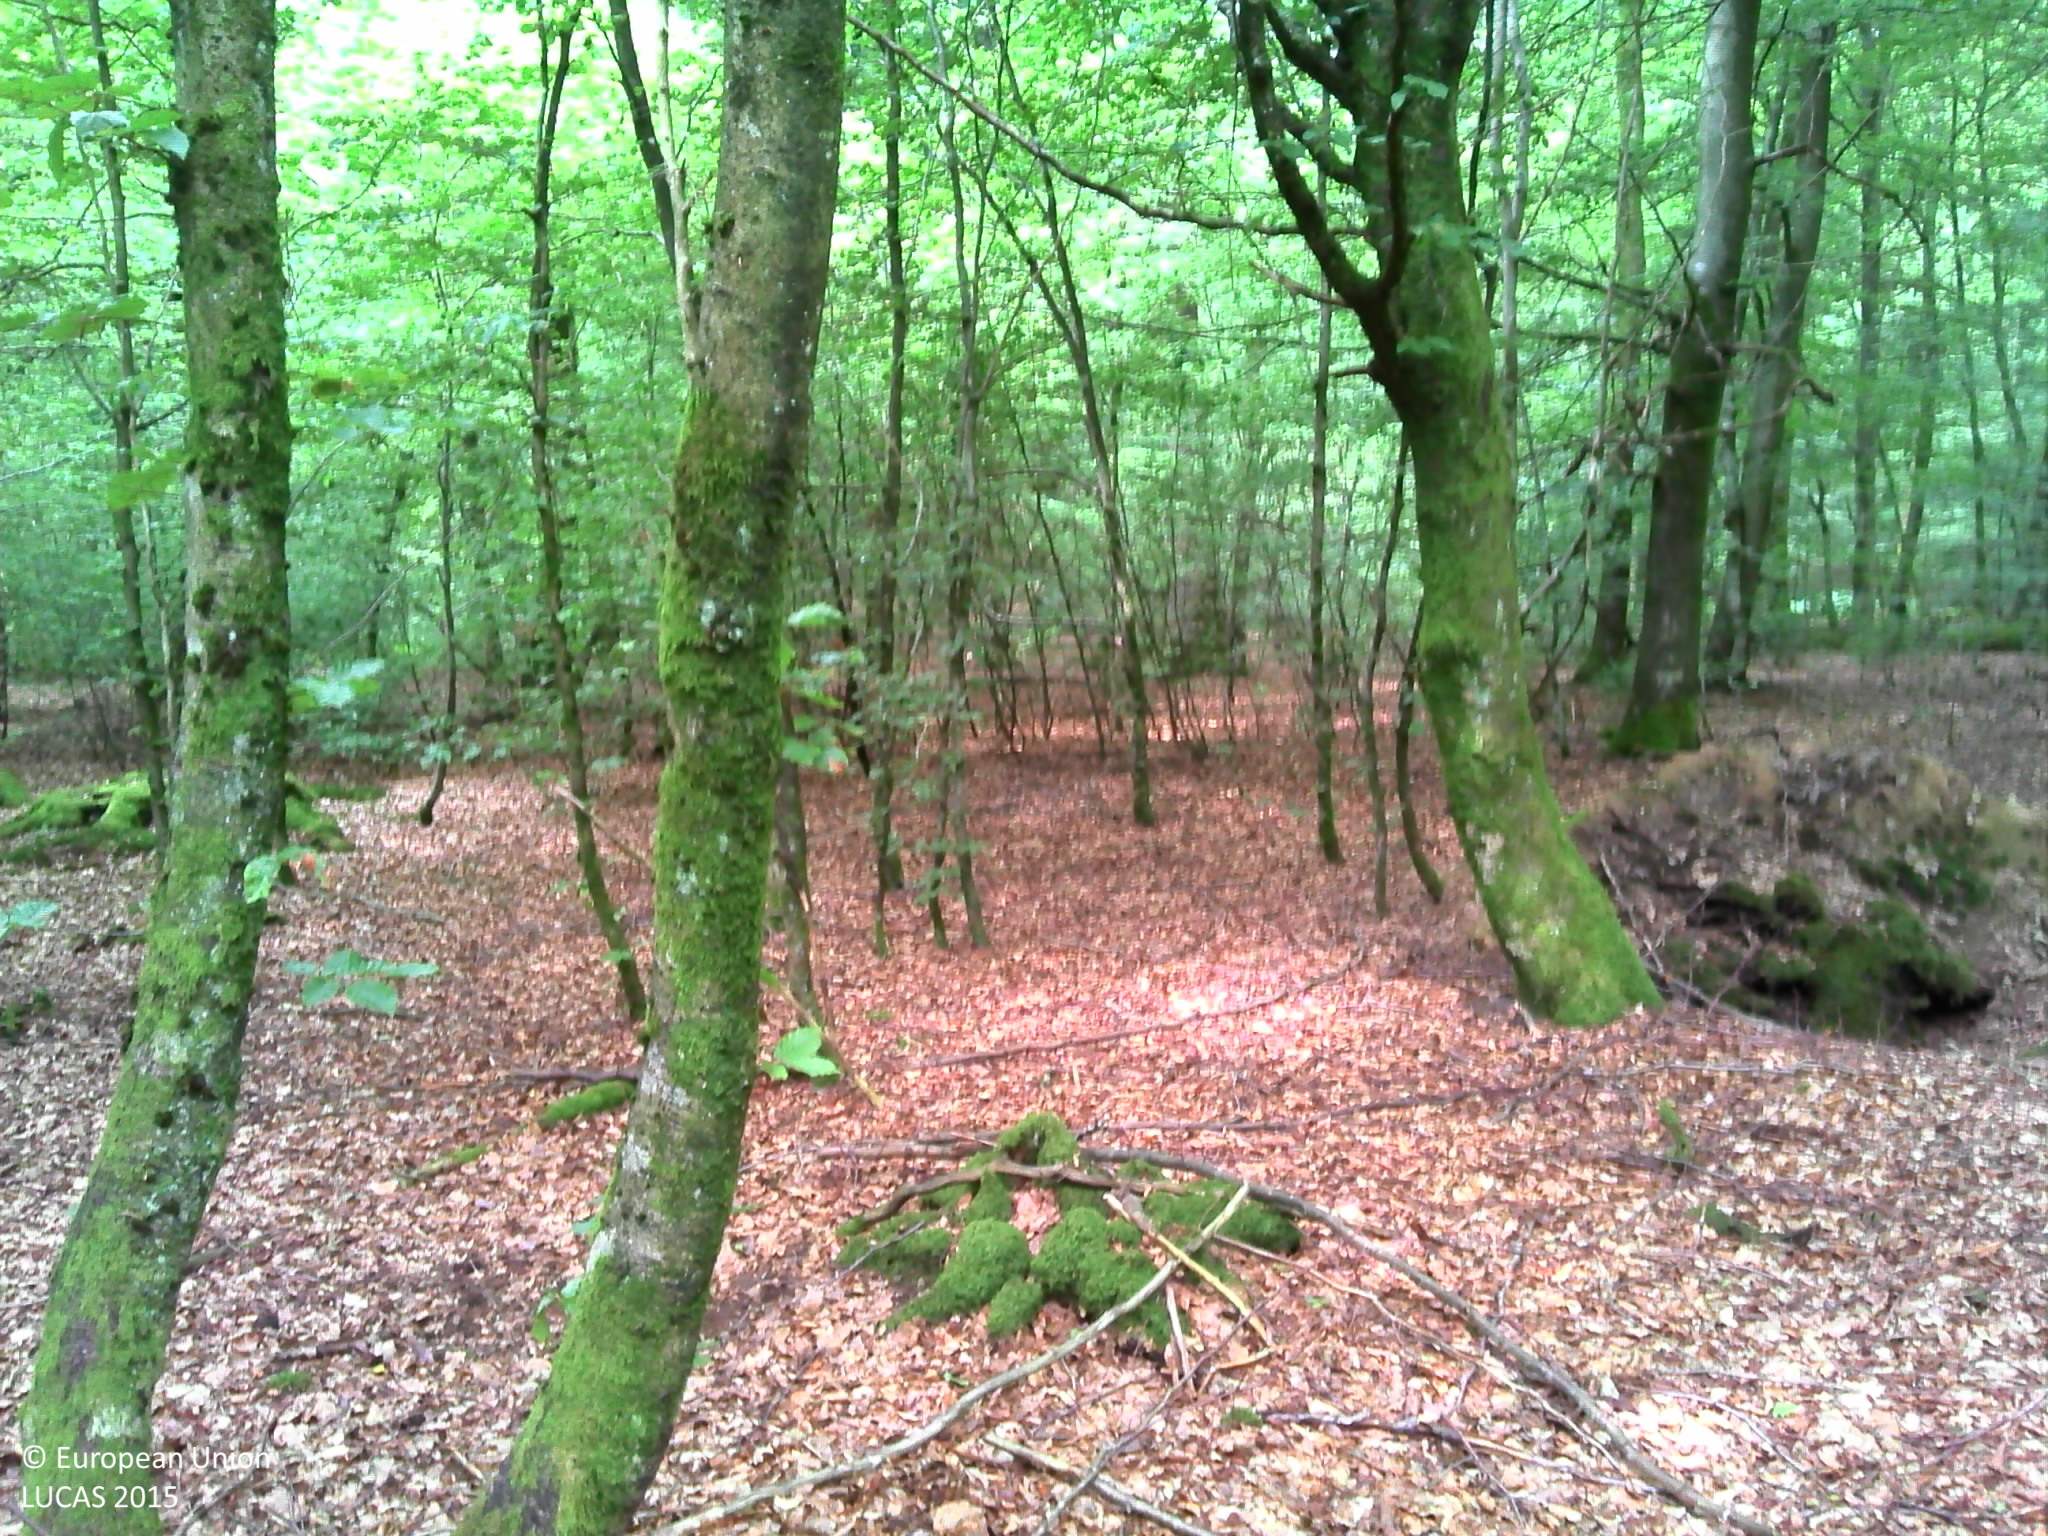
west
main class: Woodland
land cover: Broadleaved woodland
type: beech forest
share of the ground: > 75 %
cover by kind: broadleaved forest trees 100 %
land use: Forestry
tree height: > 5 m
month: July
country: BE
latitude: 49.7381
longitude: 5.5722
